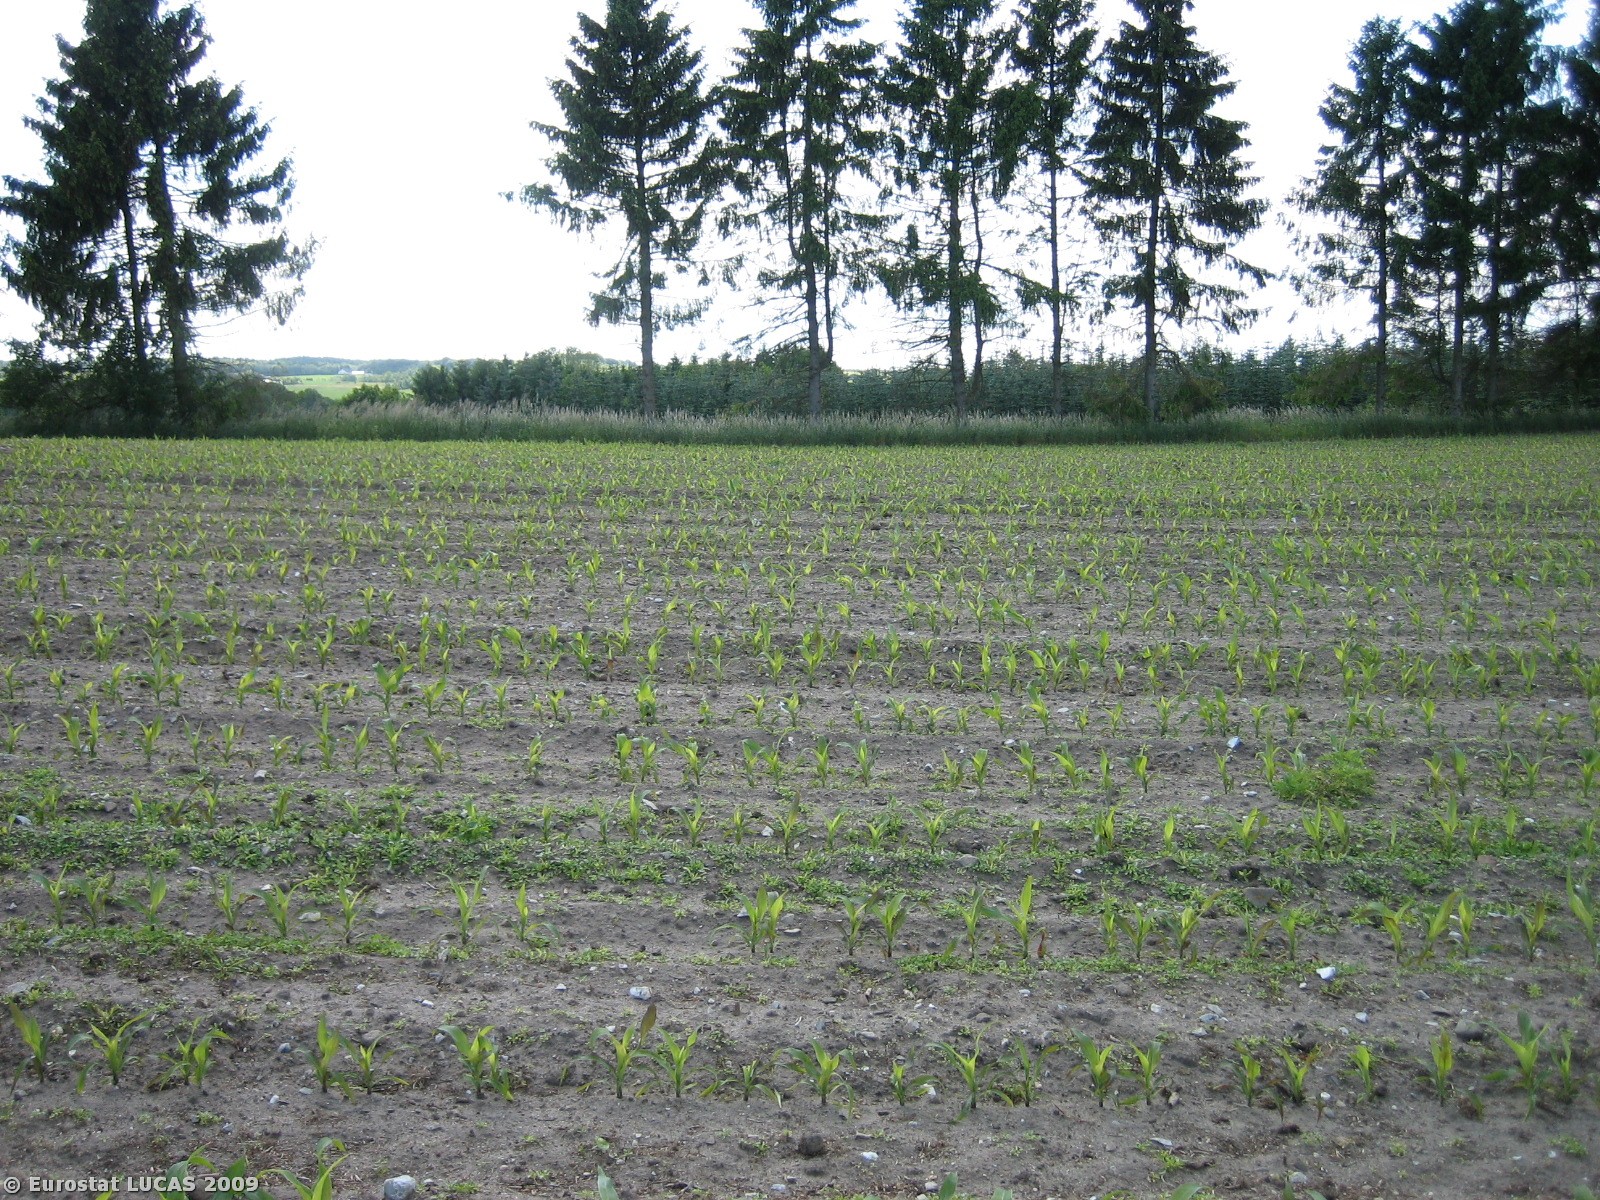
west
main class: Cropland
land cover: Maize
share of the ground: < 10 %
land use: Agriculture (excluding fallow land and kitchen gardens)
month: June
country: DK
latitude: 56.0079
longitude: 9.8558
